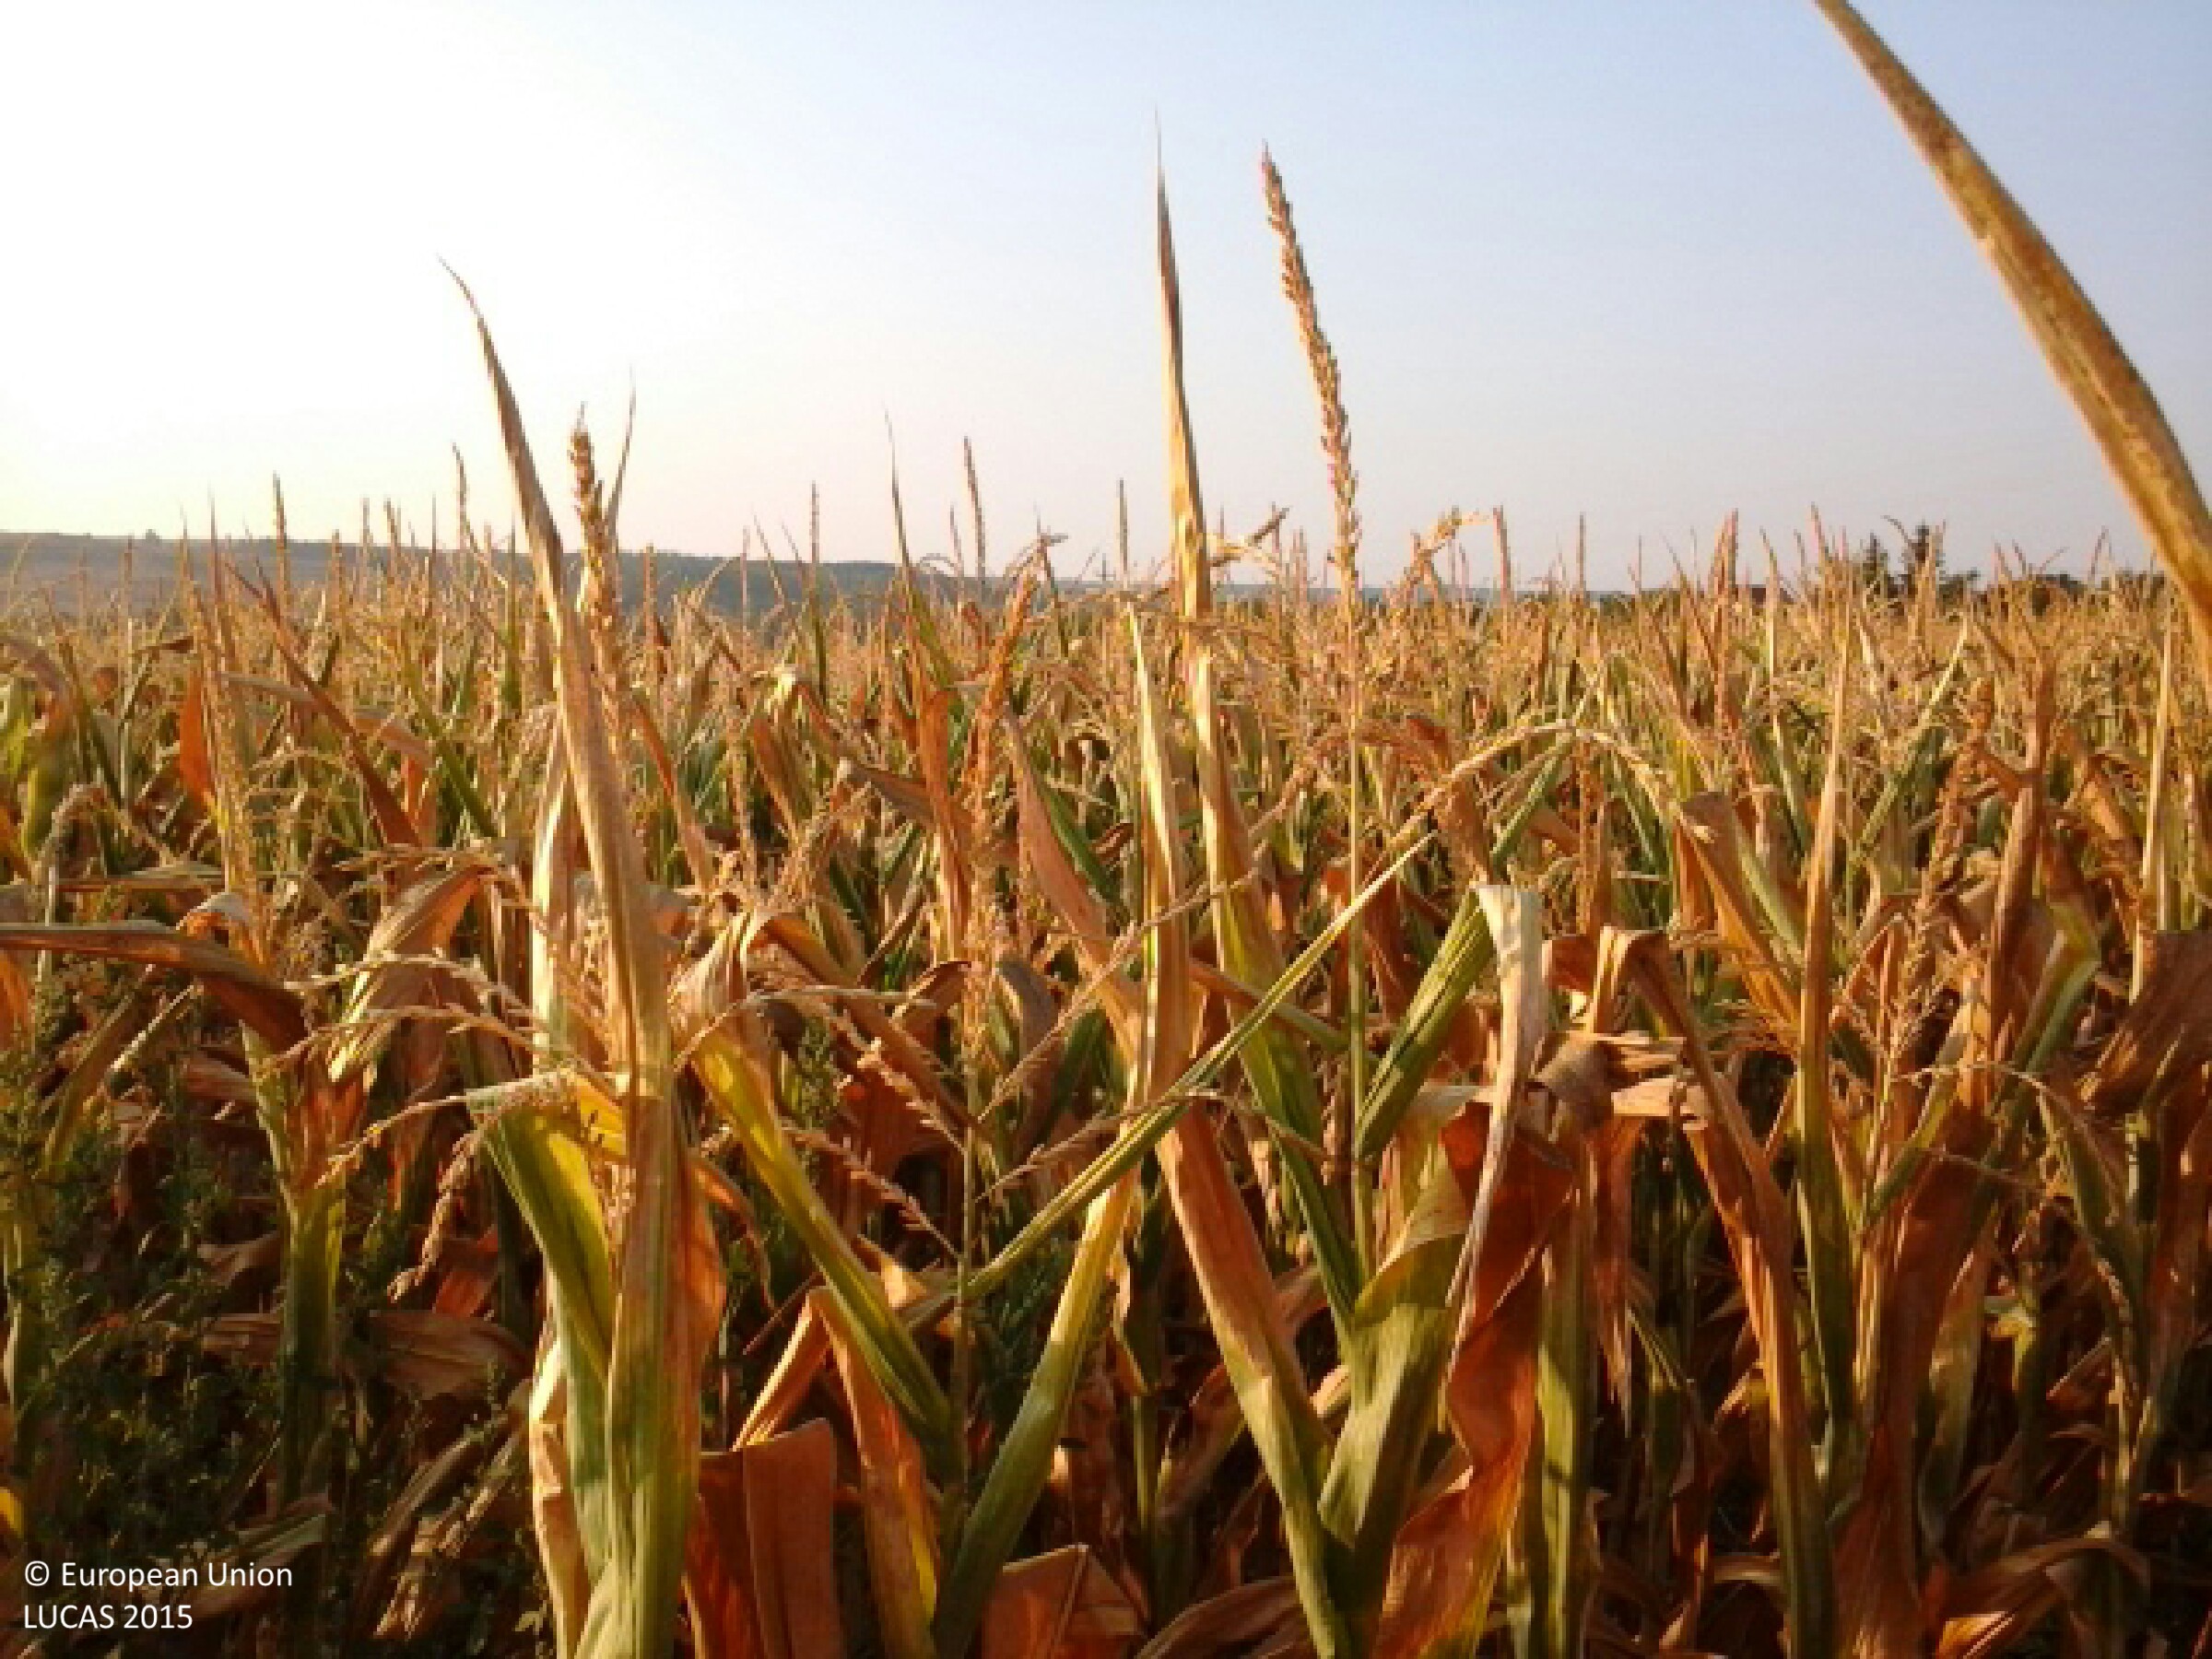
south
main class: Cropland
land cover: Maize
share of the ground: > 75 %
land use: Agriculture (excluding fallow land and kitchen gardens)
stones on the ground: < 10 %
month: August
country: HU
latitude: 47.2606
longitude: 18.5106
